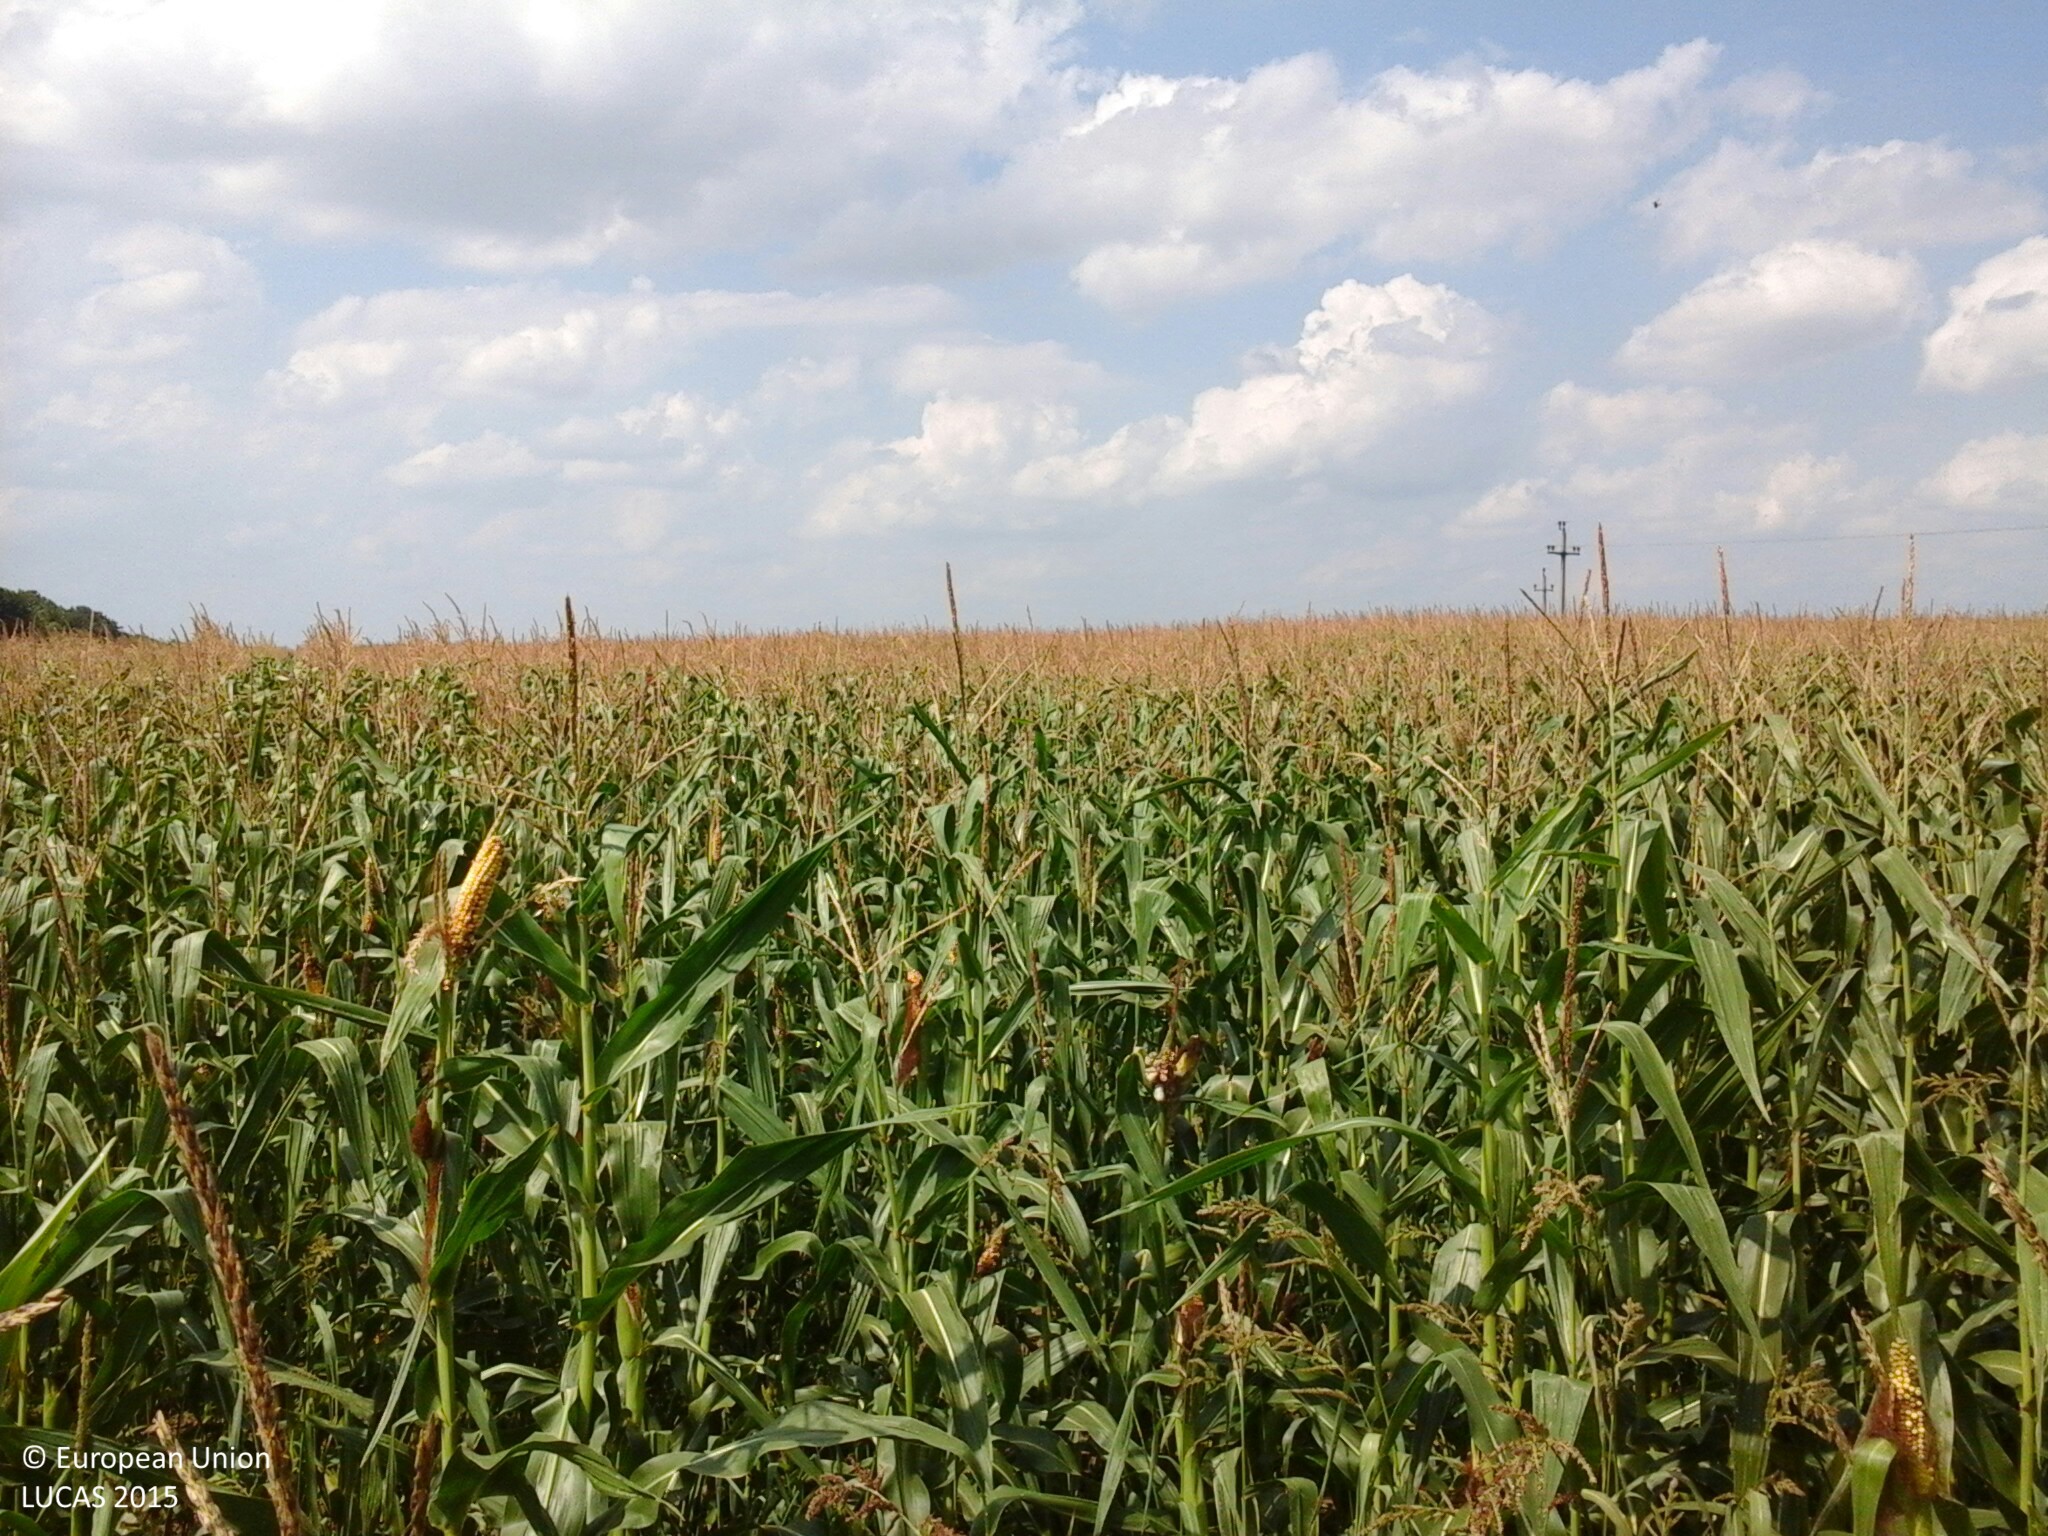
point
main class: Cropland
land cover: Maize
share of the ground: > 75 %
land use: Agriculture (excluding fallow land and kitchen gardens)
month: August
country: HU
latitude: 47.0347
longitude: 18.1560
